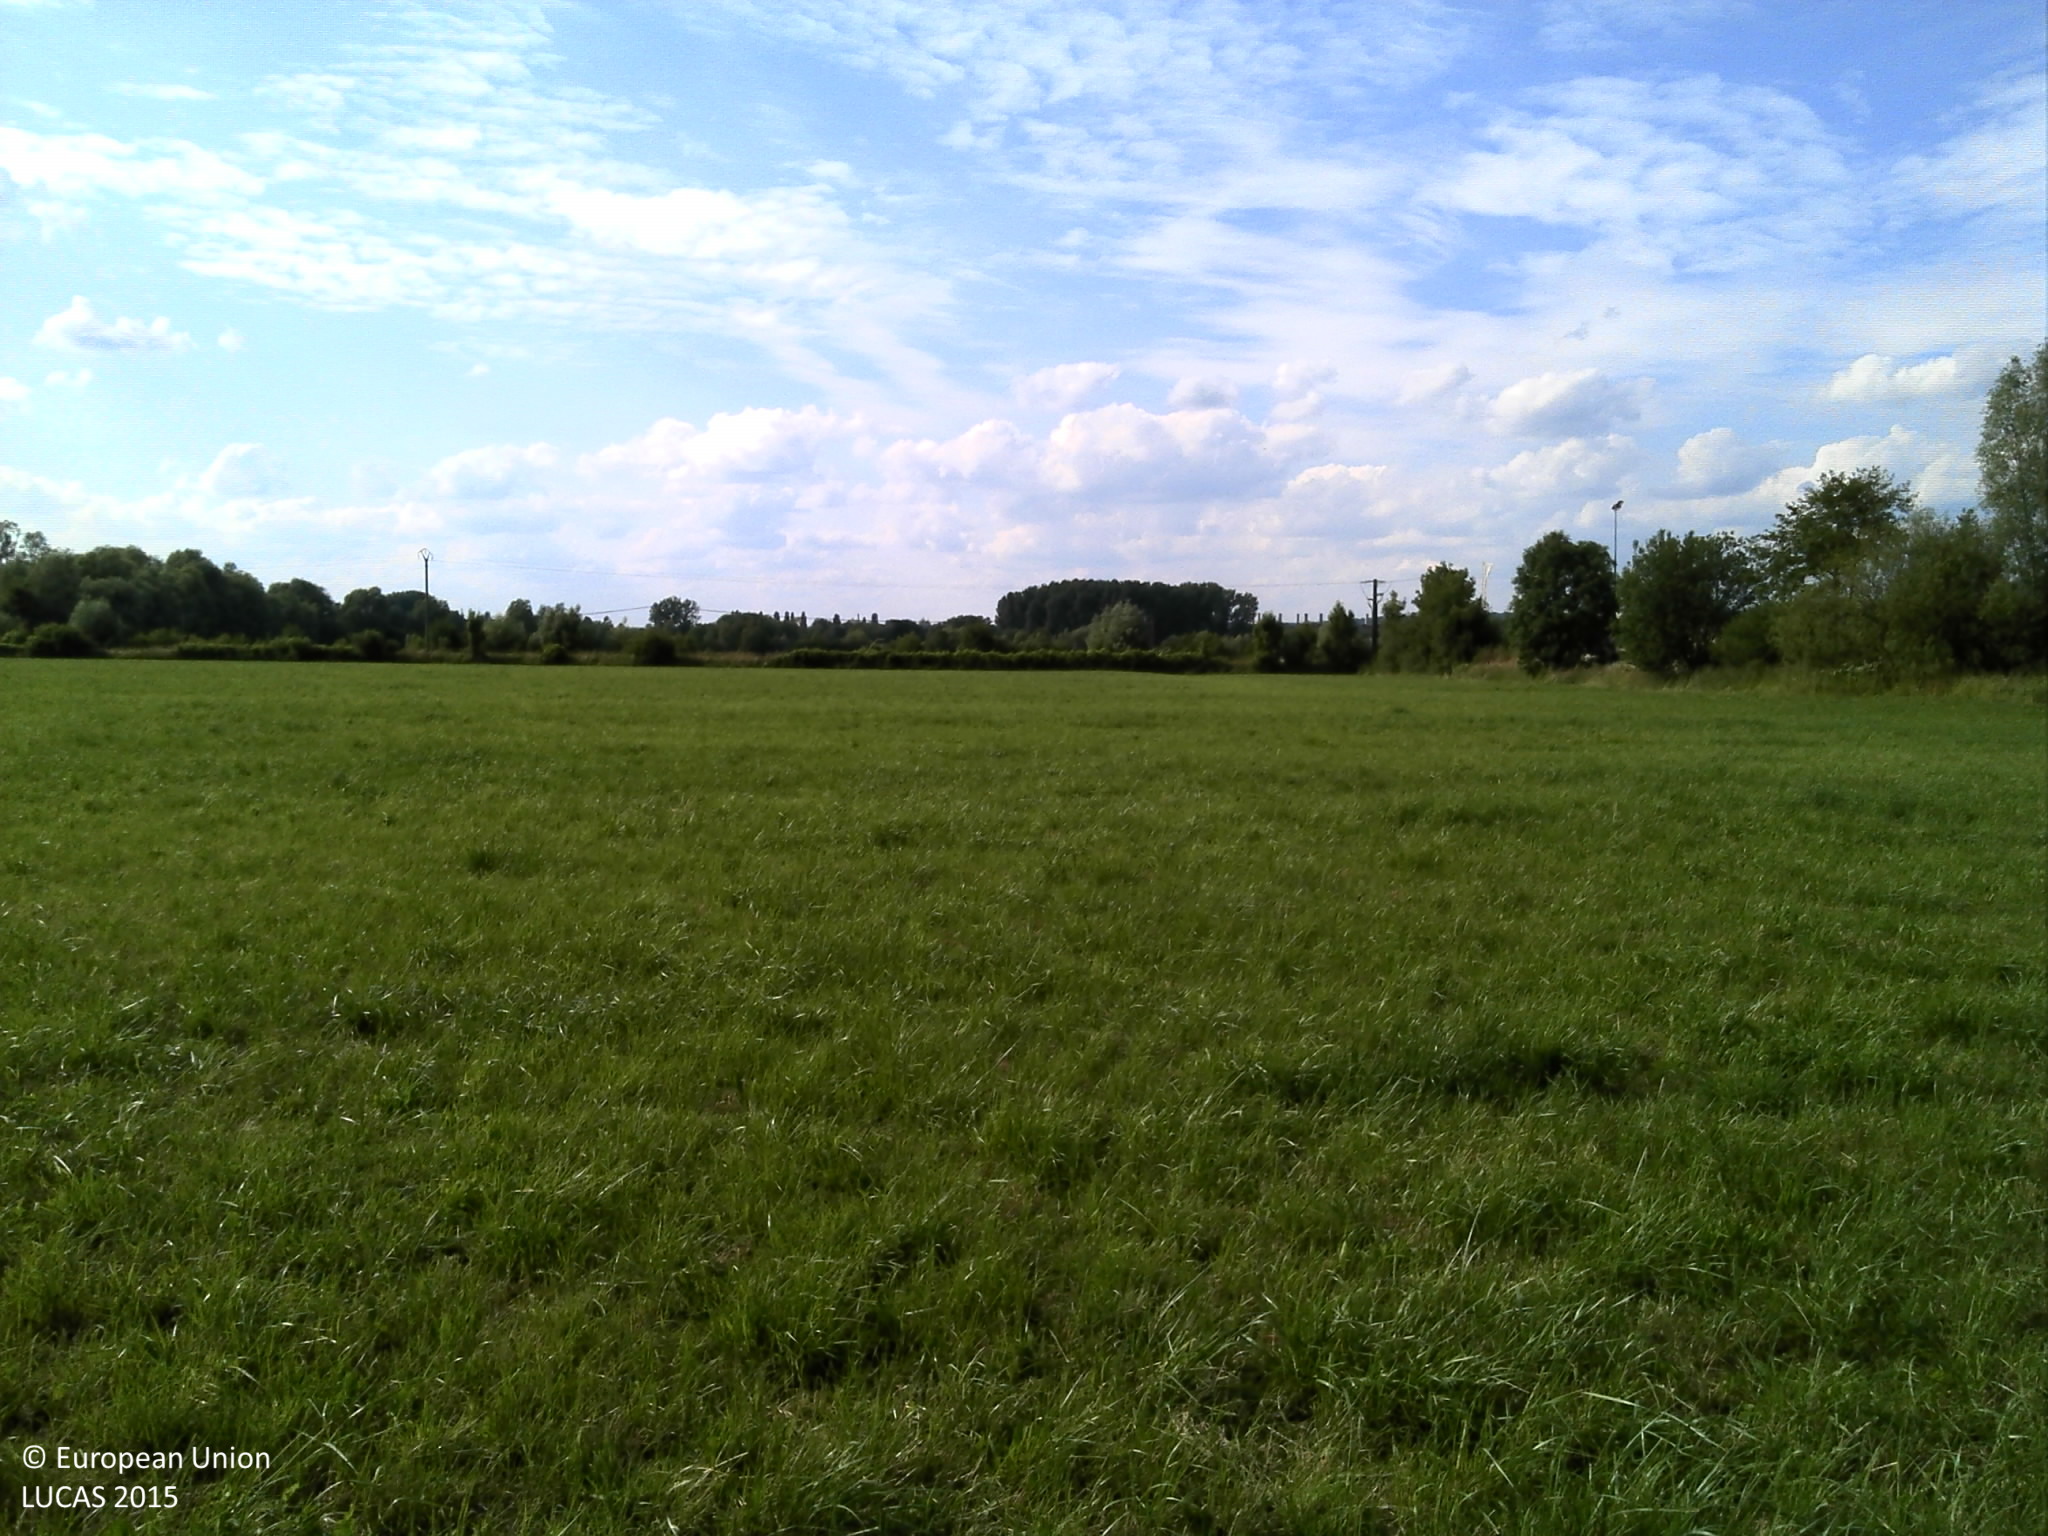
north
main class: Grassland
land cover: Grassland without tree/shrub cover
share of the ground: > 75 %
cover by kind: herbaceous plants 100 %
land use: Agriculture (excluding fallow land and kitchen gardens)
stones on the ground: < 10 %
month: June
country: FR
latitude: 49.7218
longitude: 4.7675
